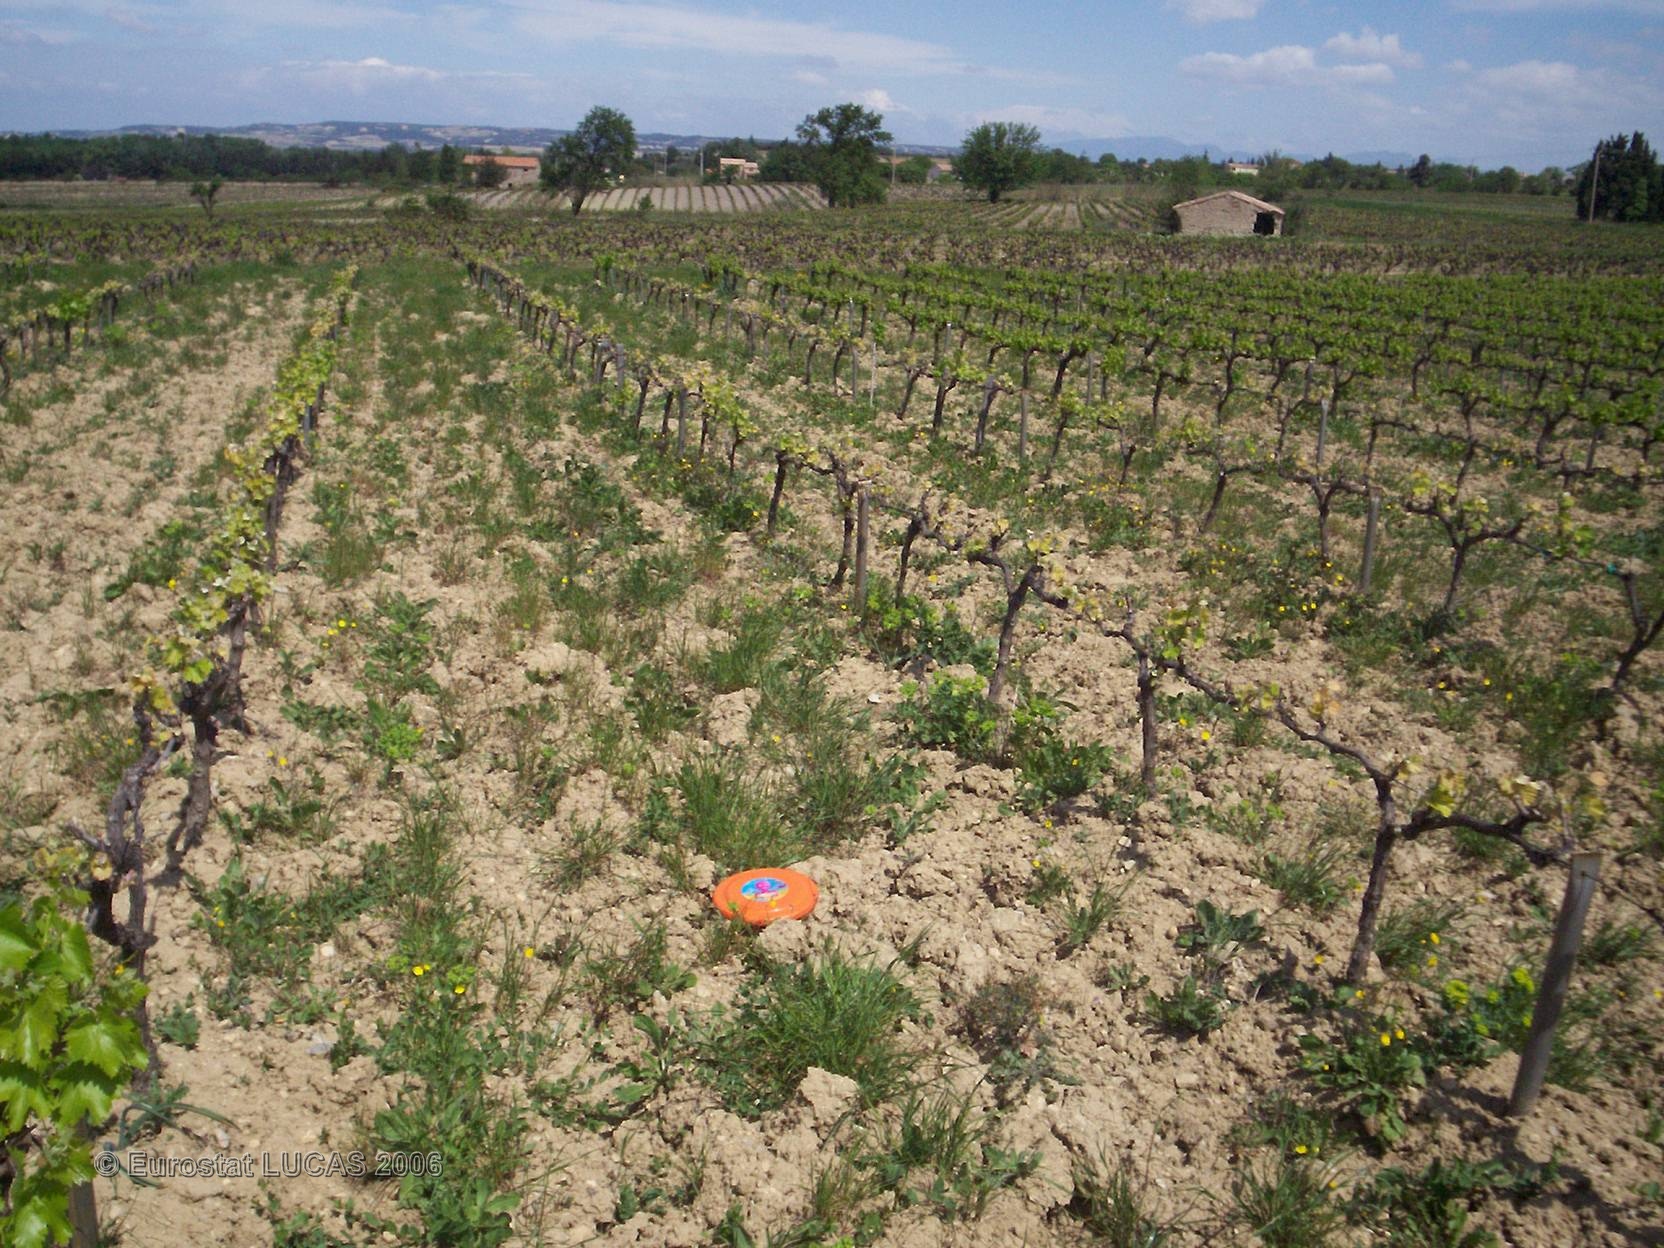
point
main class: Cropland
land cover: Vineyards
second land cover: Grassland with sparse tree/shrub cover
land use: Agriculture (excluding fallow land and kitchen gardens)
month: April
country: FR
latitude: 44.1563
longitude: 4.9690
